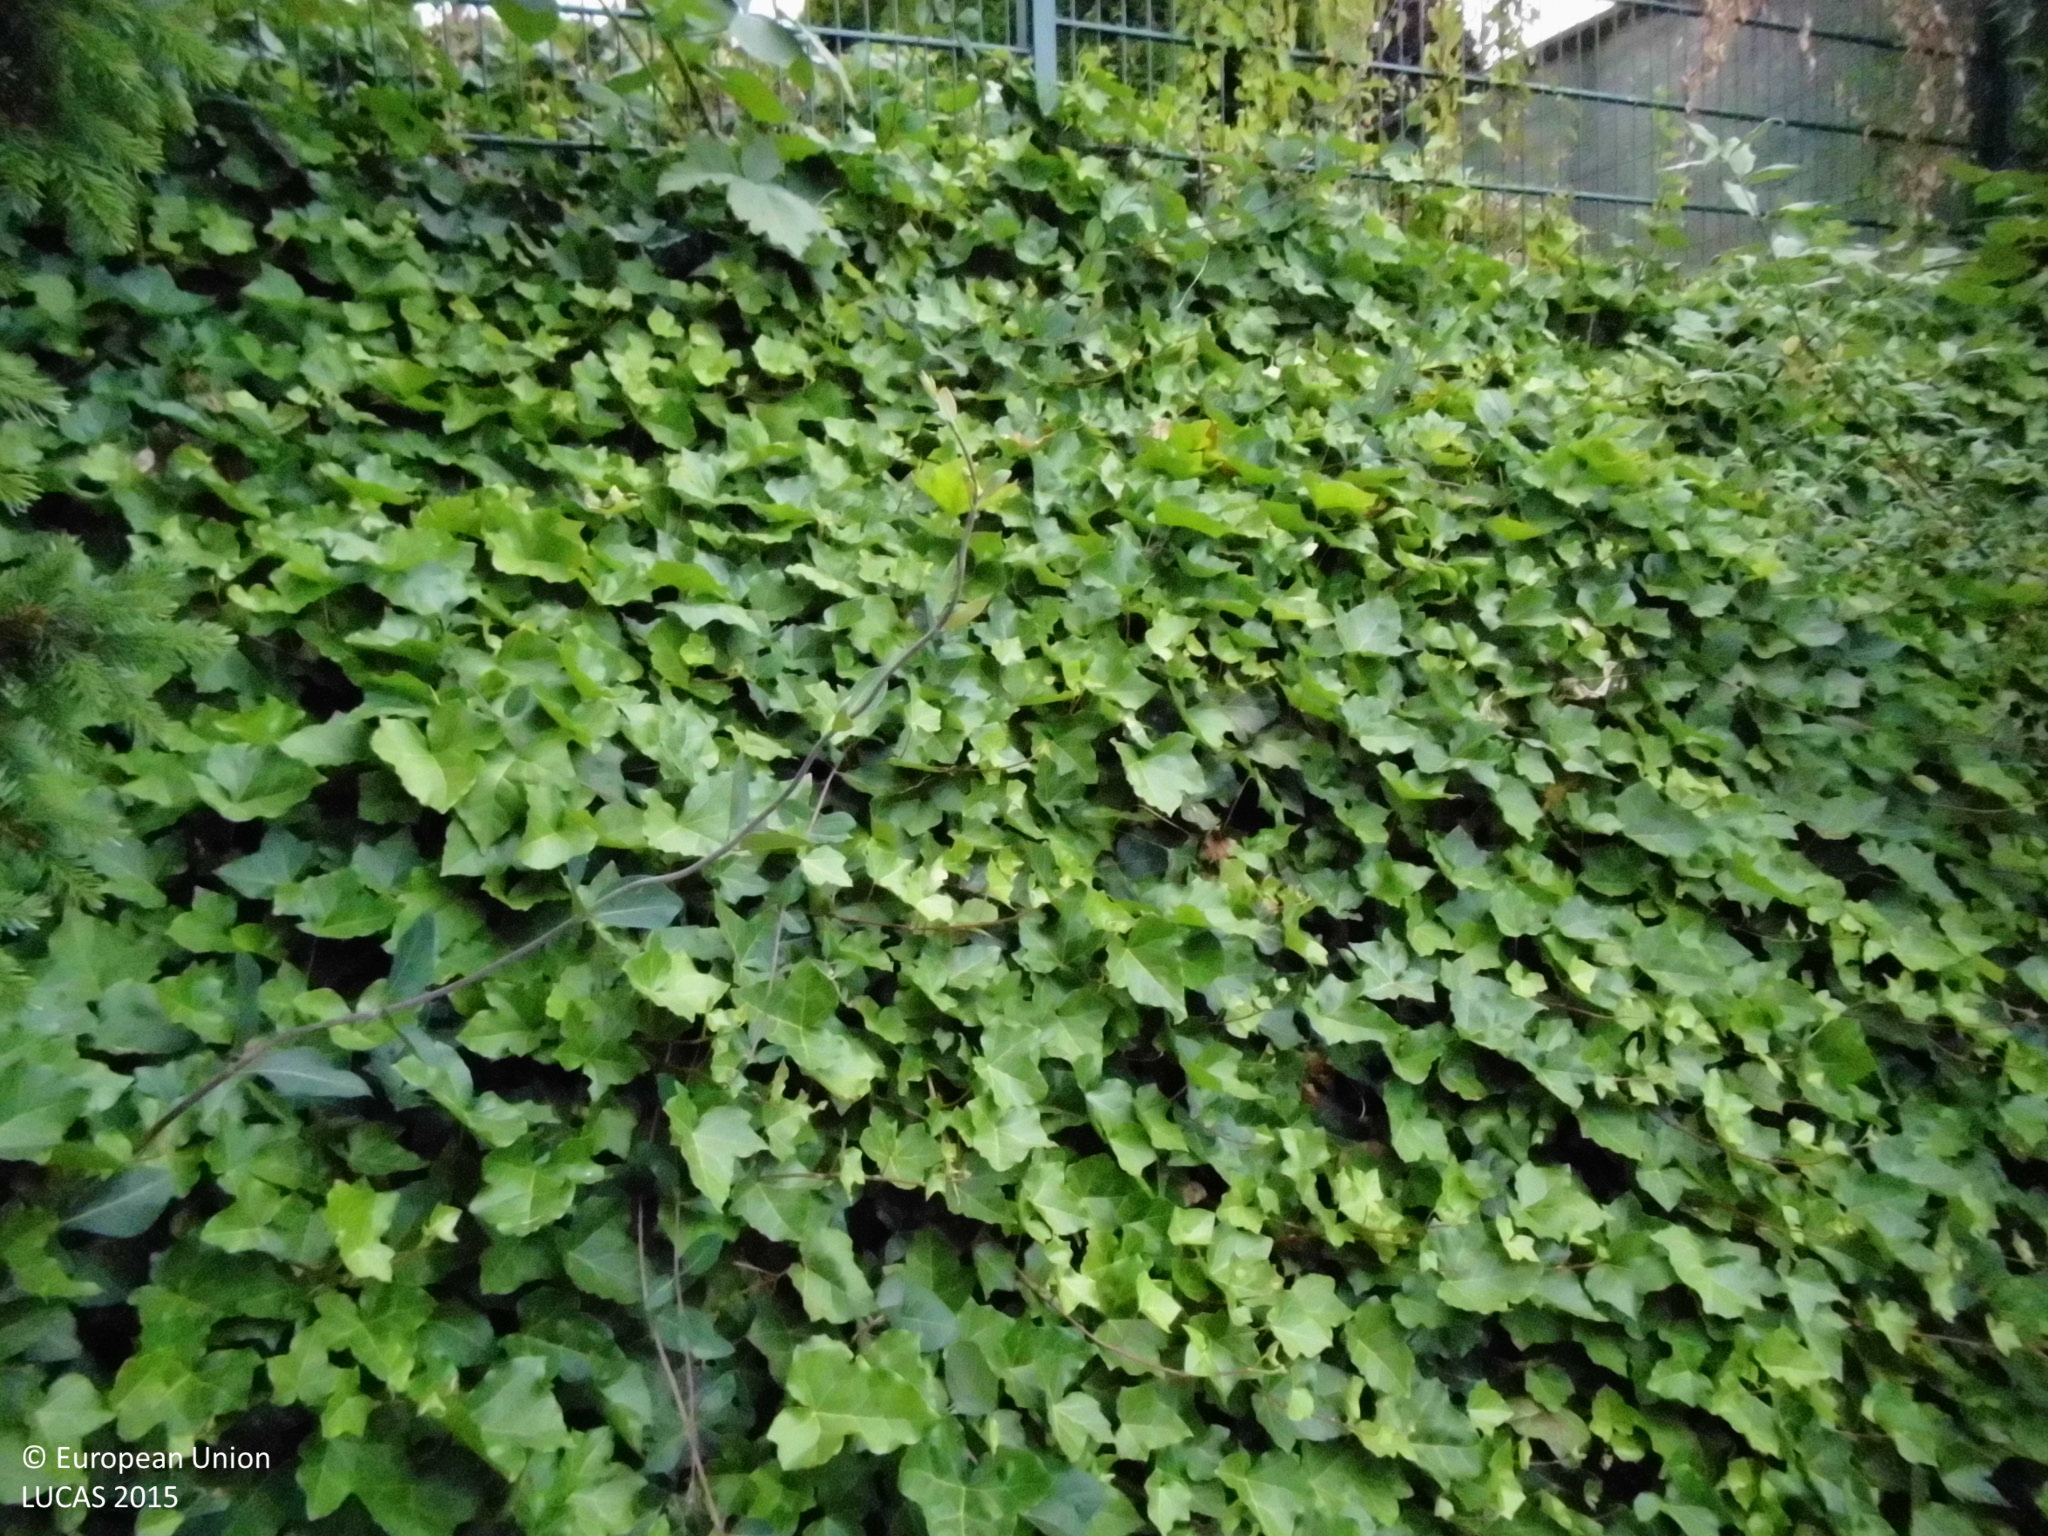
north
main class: Woodland
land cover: Other coniferous woodland
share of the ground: > 75 %
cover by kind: coniferous forest trees 70 %, broadleaved forest trees 20 %, shrubs 5 %, herbaceous plants 5 %
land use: Residential
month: June
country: DE
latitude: 51.3438
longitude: 7.4879
